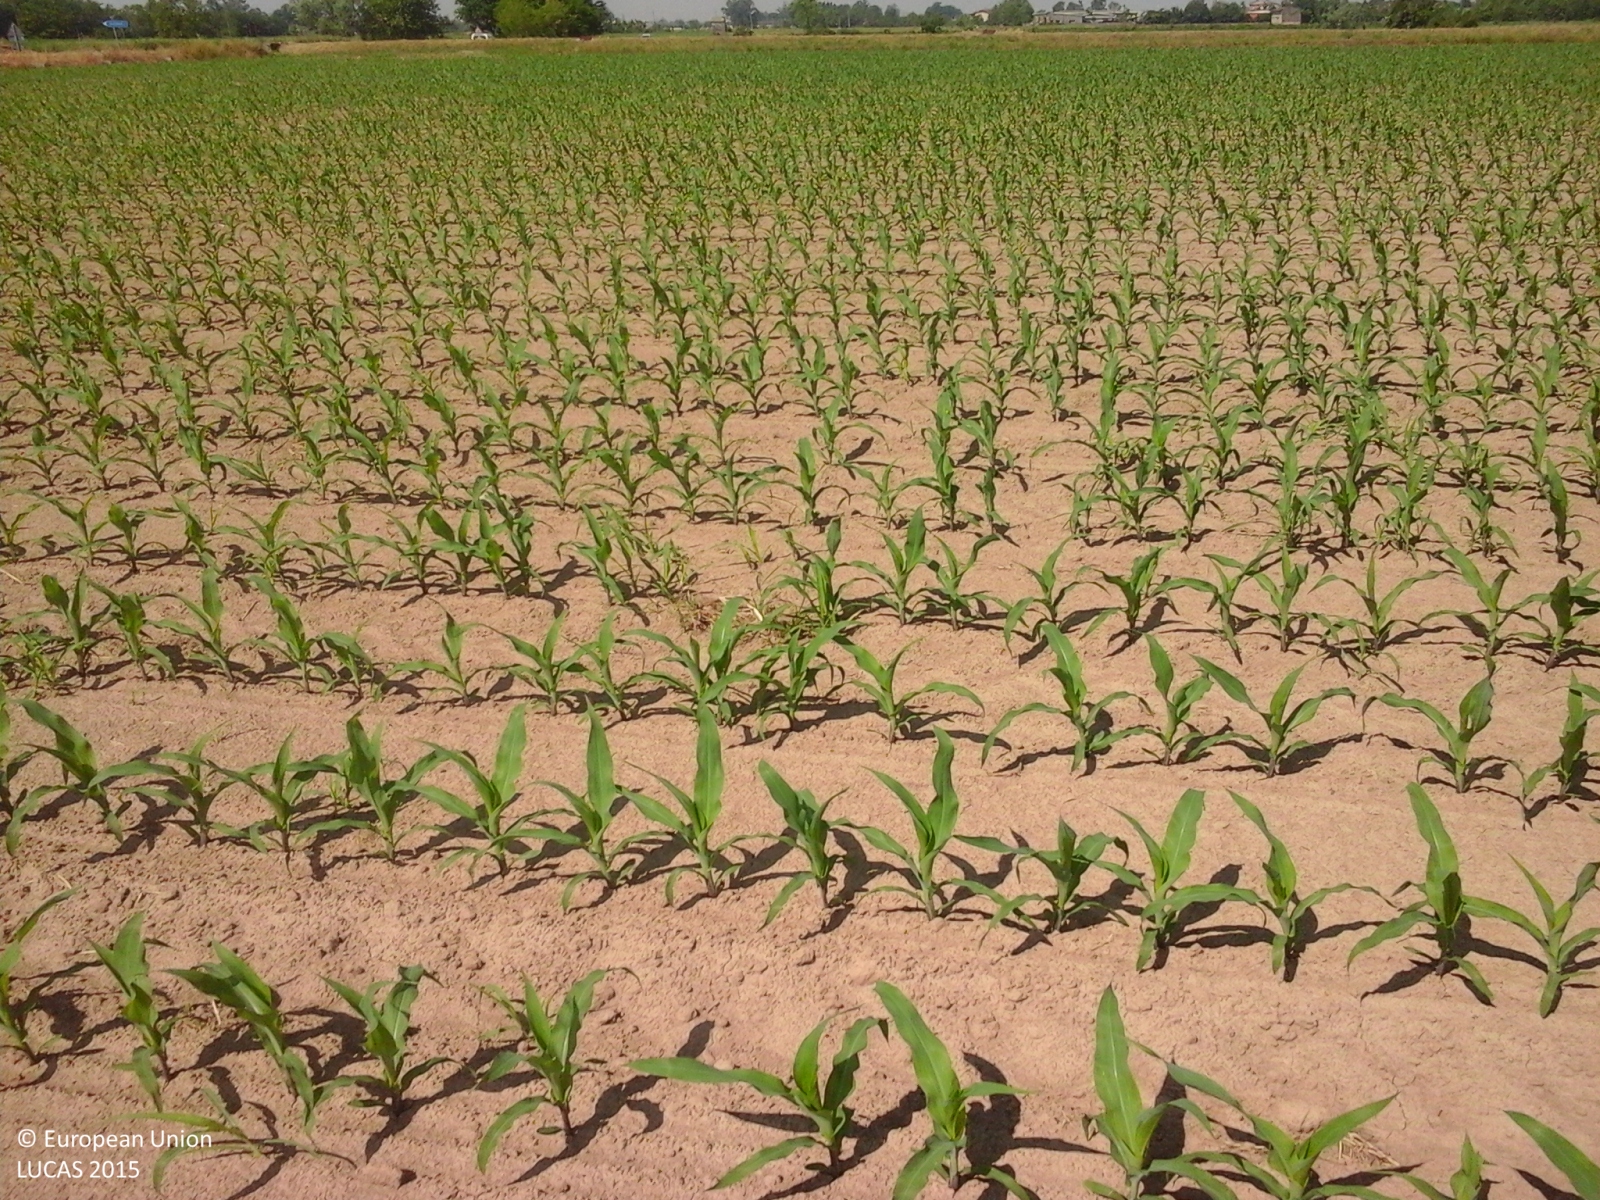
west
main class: Cropland
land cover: Maize
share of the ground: 25 - 50 %
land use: Agriculture (excluding fallow land and kitchen gardens)
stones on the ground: < 10 %
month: May
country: IT
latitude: 45.1979
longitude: 10.1652
